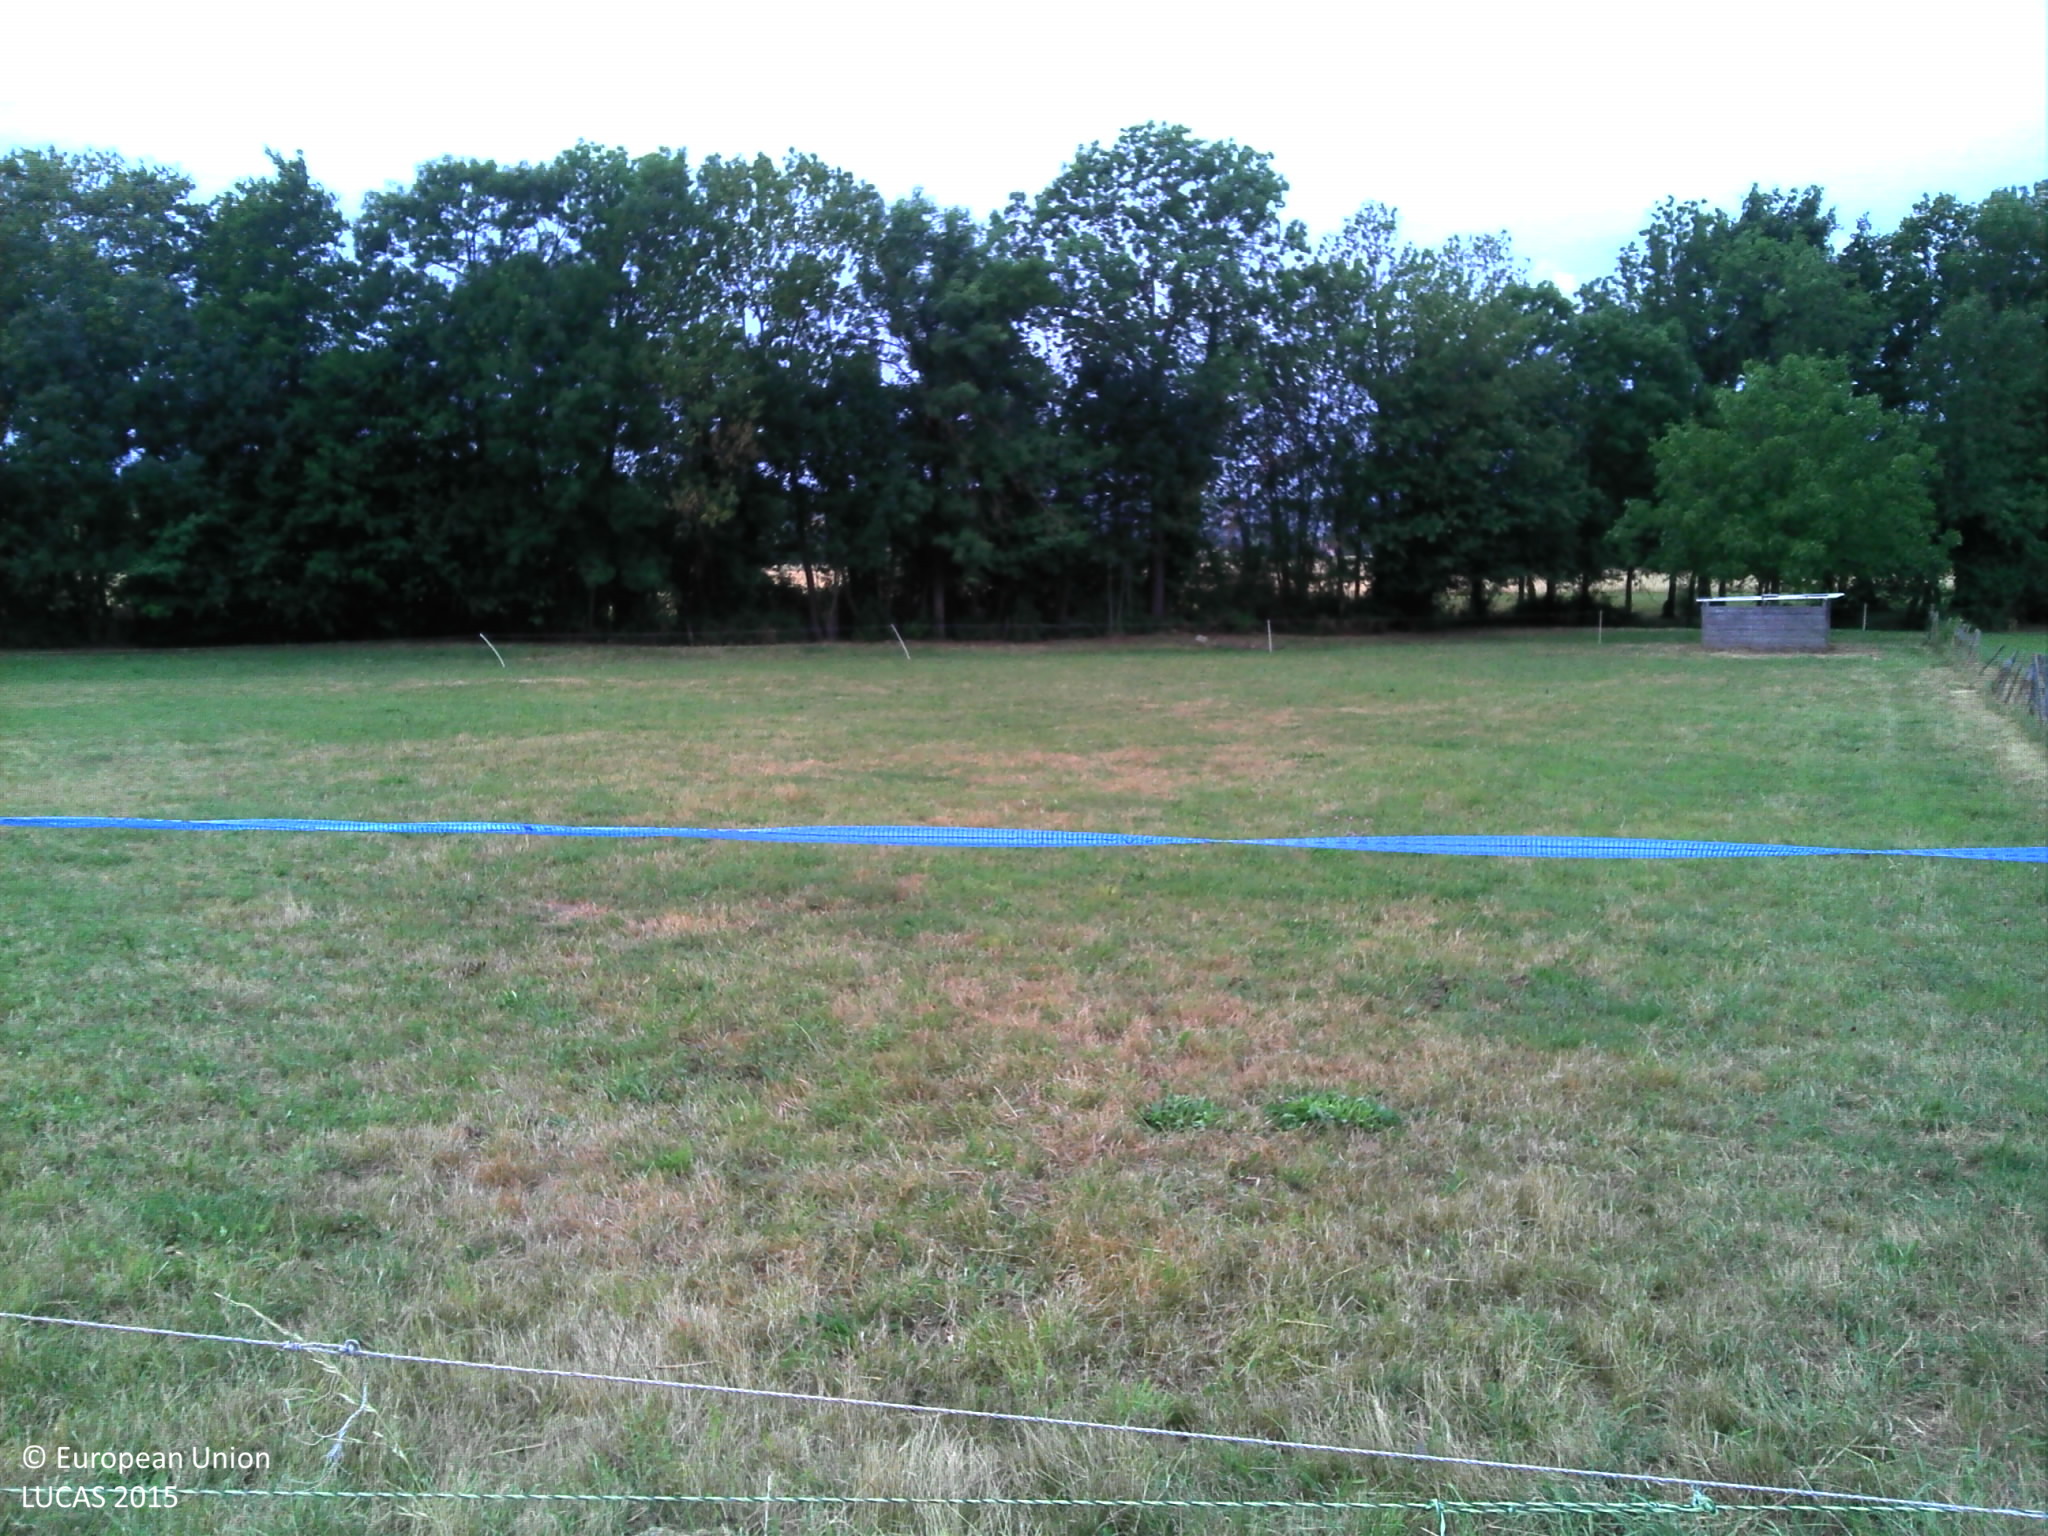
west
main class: Grassland
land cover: Grassland without tree/shrub cover
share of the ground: > 75 %
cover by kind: herbaceous plants 100 %
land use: Agriculture (excluding fallow land and kitchen gardens)
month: July
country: FR
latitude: 45.4751
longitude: 4.9771
